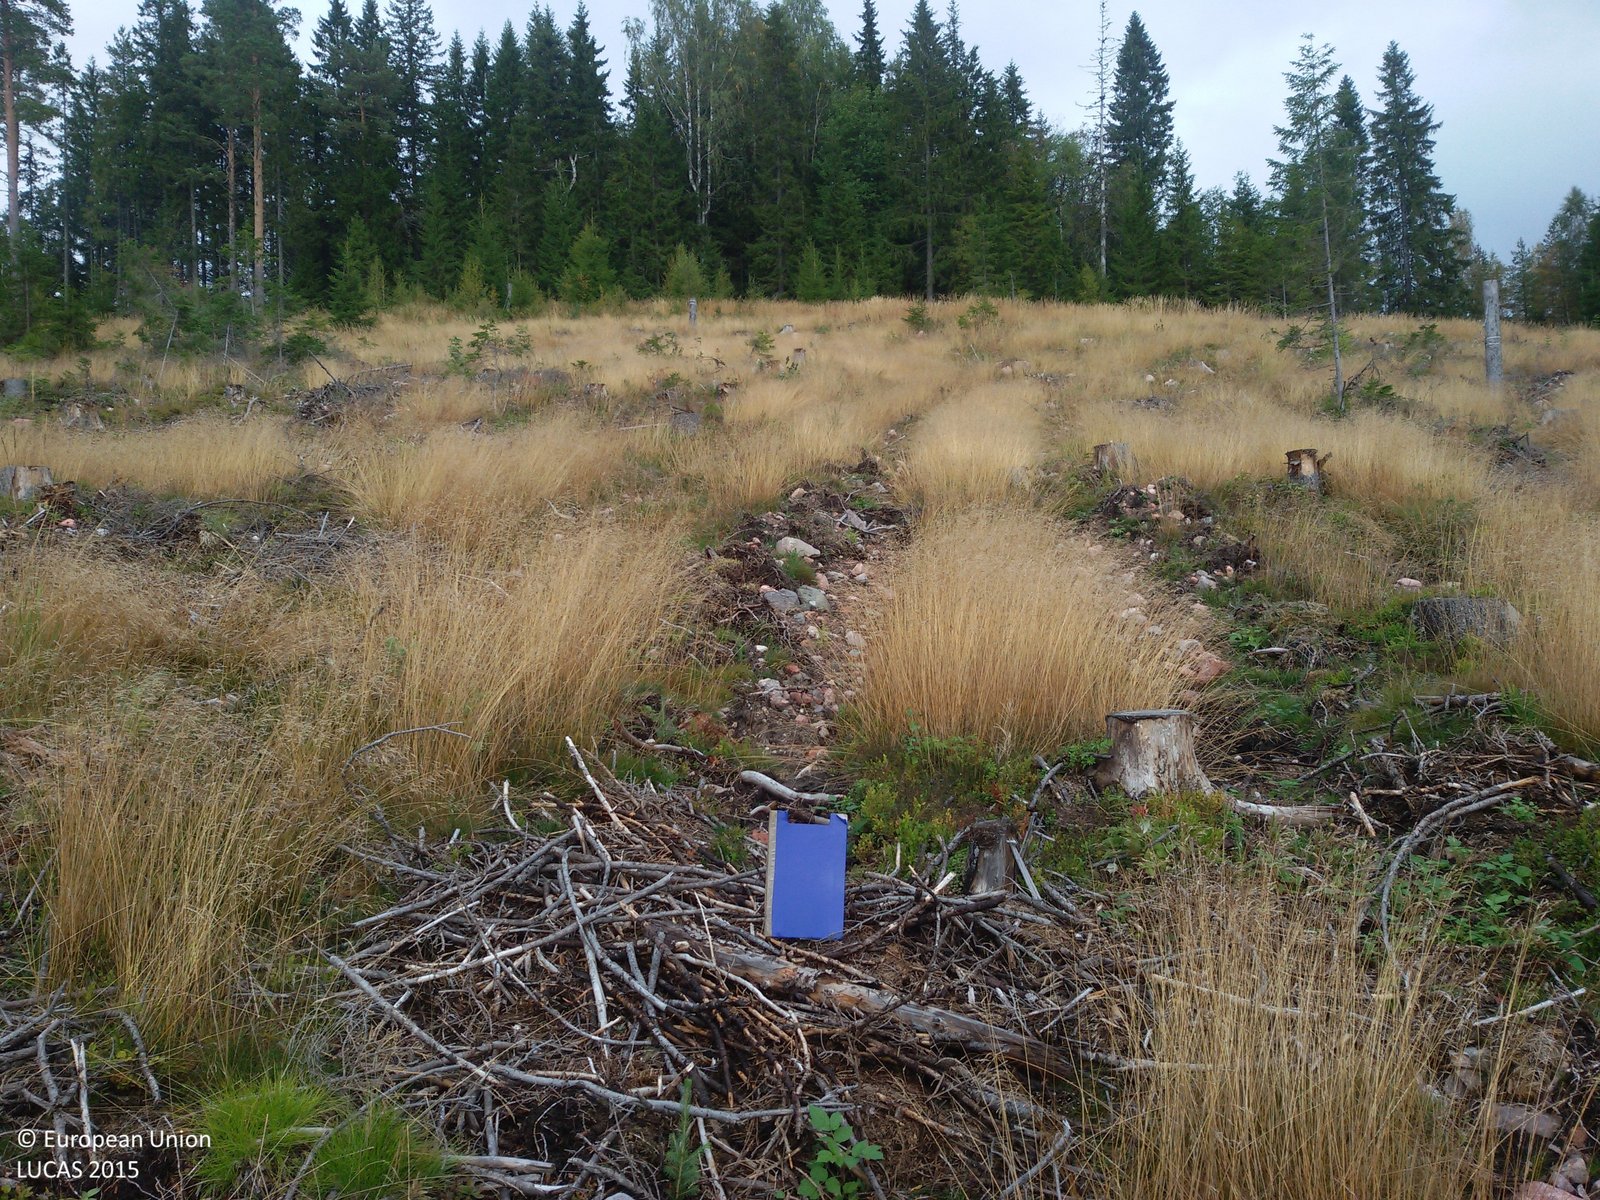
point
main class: Woodland
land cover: Spruce dominated coniferous woodland
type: boreal forest
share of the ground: < 10 %
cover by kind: herbaceous plants 70 %, unconsolidated bare surface 15 %, coniferous forest trees 10 %, lichens and mosses 5 %
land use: Forestry
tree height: < 5 m
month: September
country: SE
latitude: 60.9440
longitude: 14.3248
